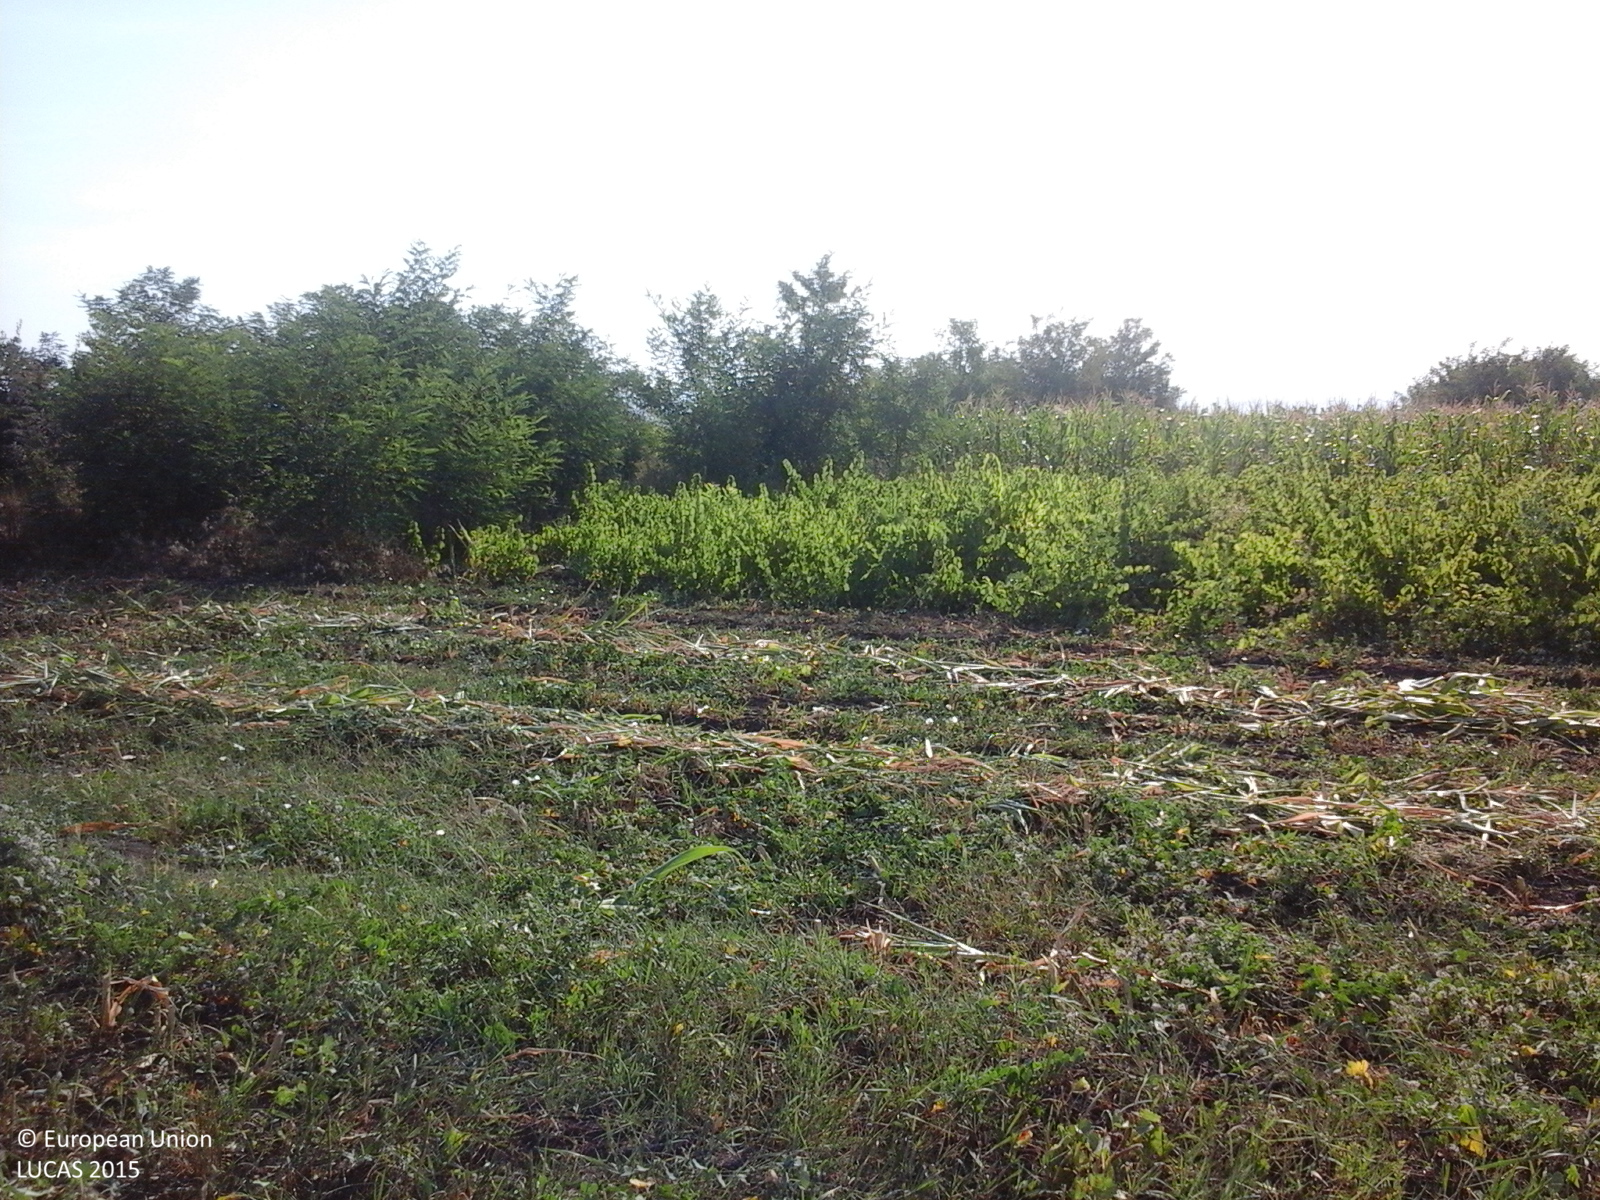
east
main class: Cropland
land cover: Maize
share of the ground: 25 - 50 %
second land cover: Spontaneously vegetated surfaces
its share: 50 - 75 %
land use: Agriculture (excluding fallow land and kitchen gardens)
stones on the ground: < 10 %
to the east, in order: Maize; Spontaneously vegetated surfaces; Vineyards; Maize; Abandoned hedges; Tracks; Common wheat; Maize
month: July
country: RO
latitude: 46.2660
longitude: 28.0976
